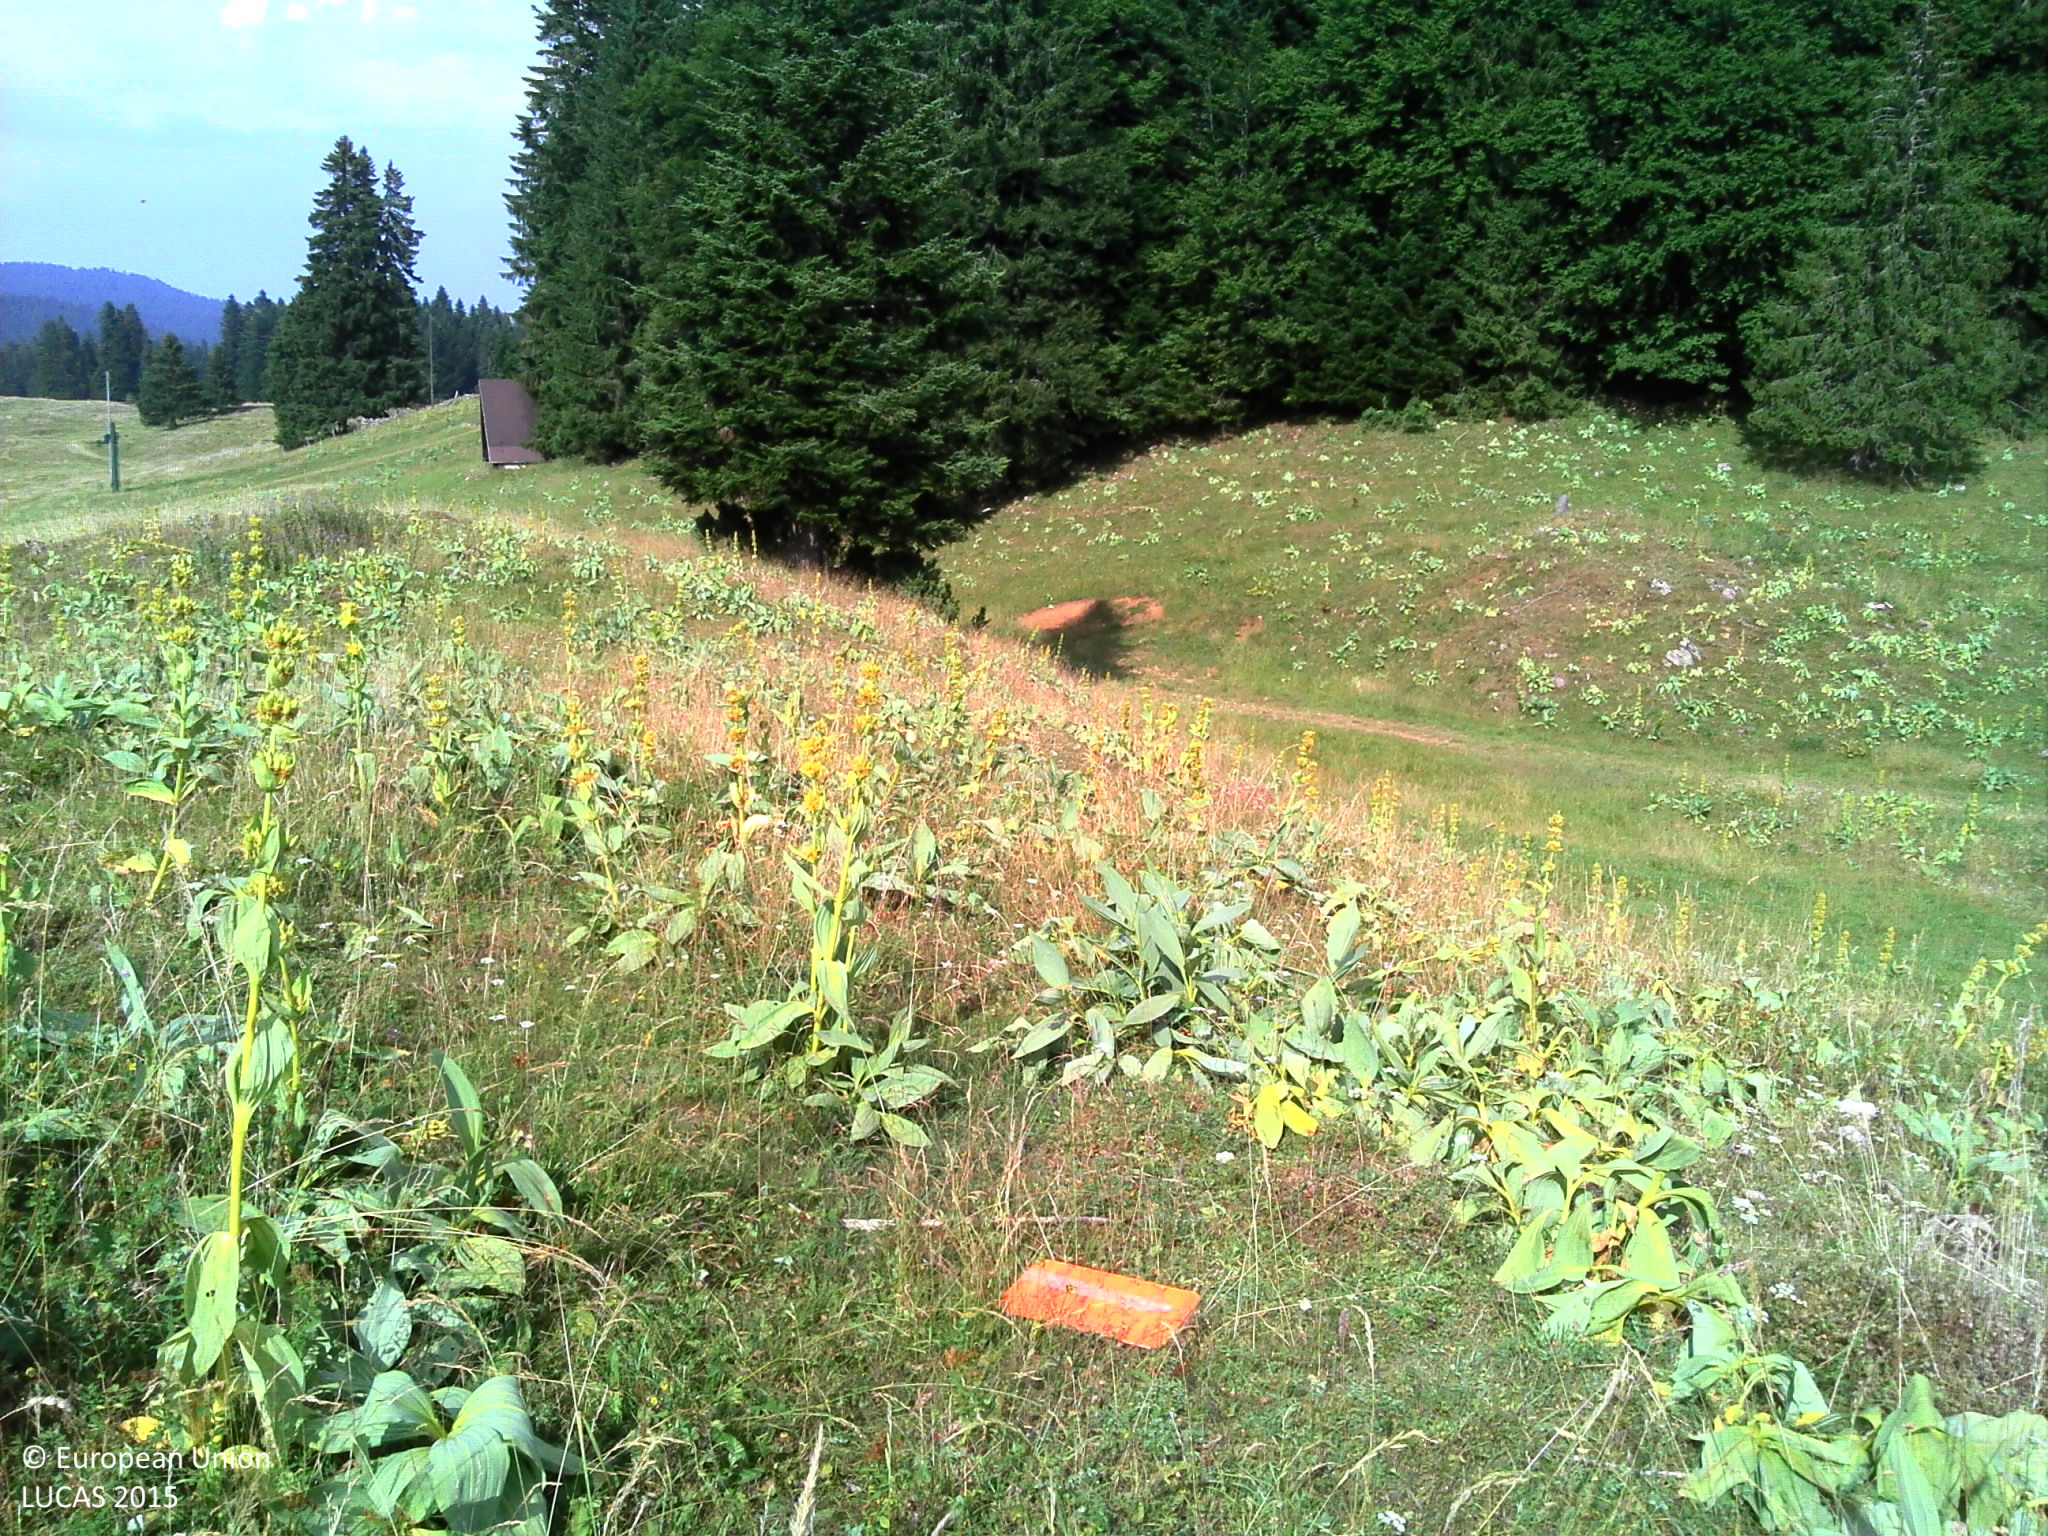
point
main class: Grassland
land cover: Grassland without tree/shrub cover
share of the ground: > 75 %
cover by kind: herbaceous plants 100 %
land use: Agriculture (excluding fallow land and kitchen gardens)
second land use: Sport
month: July
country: FR
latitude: 46.4419
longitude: 6.0851
